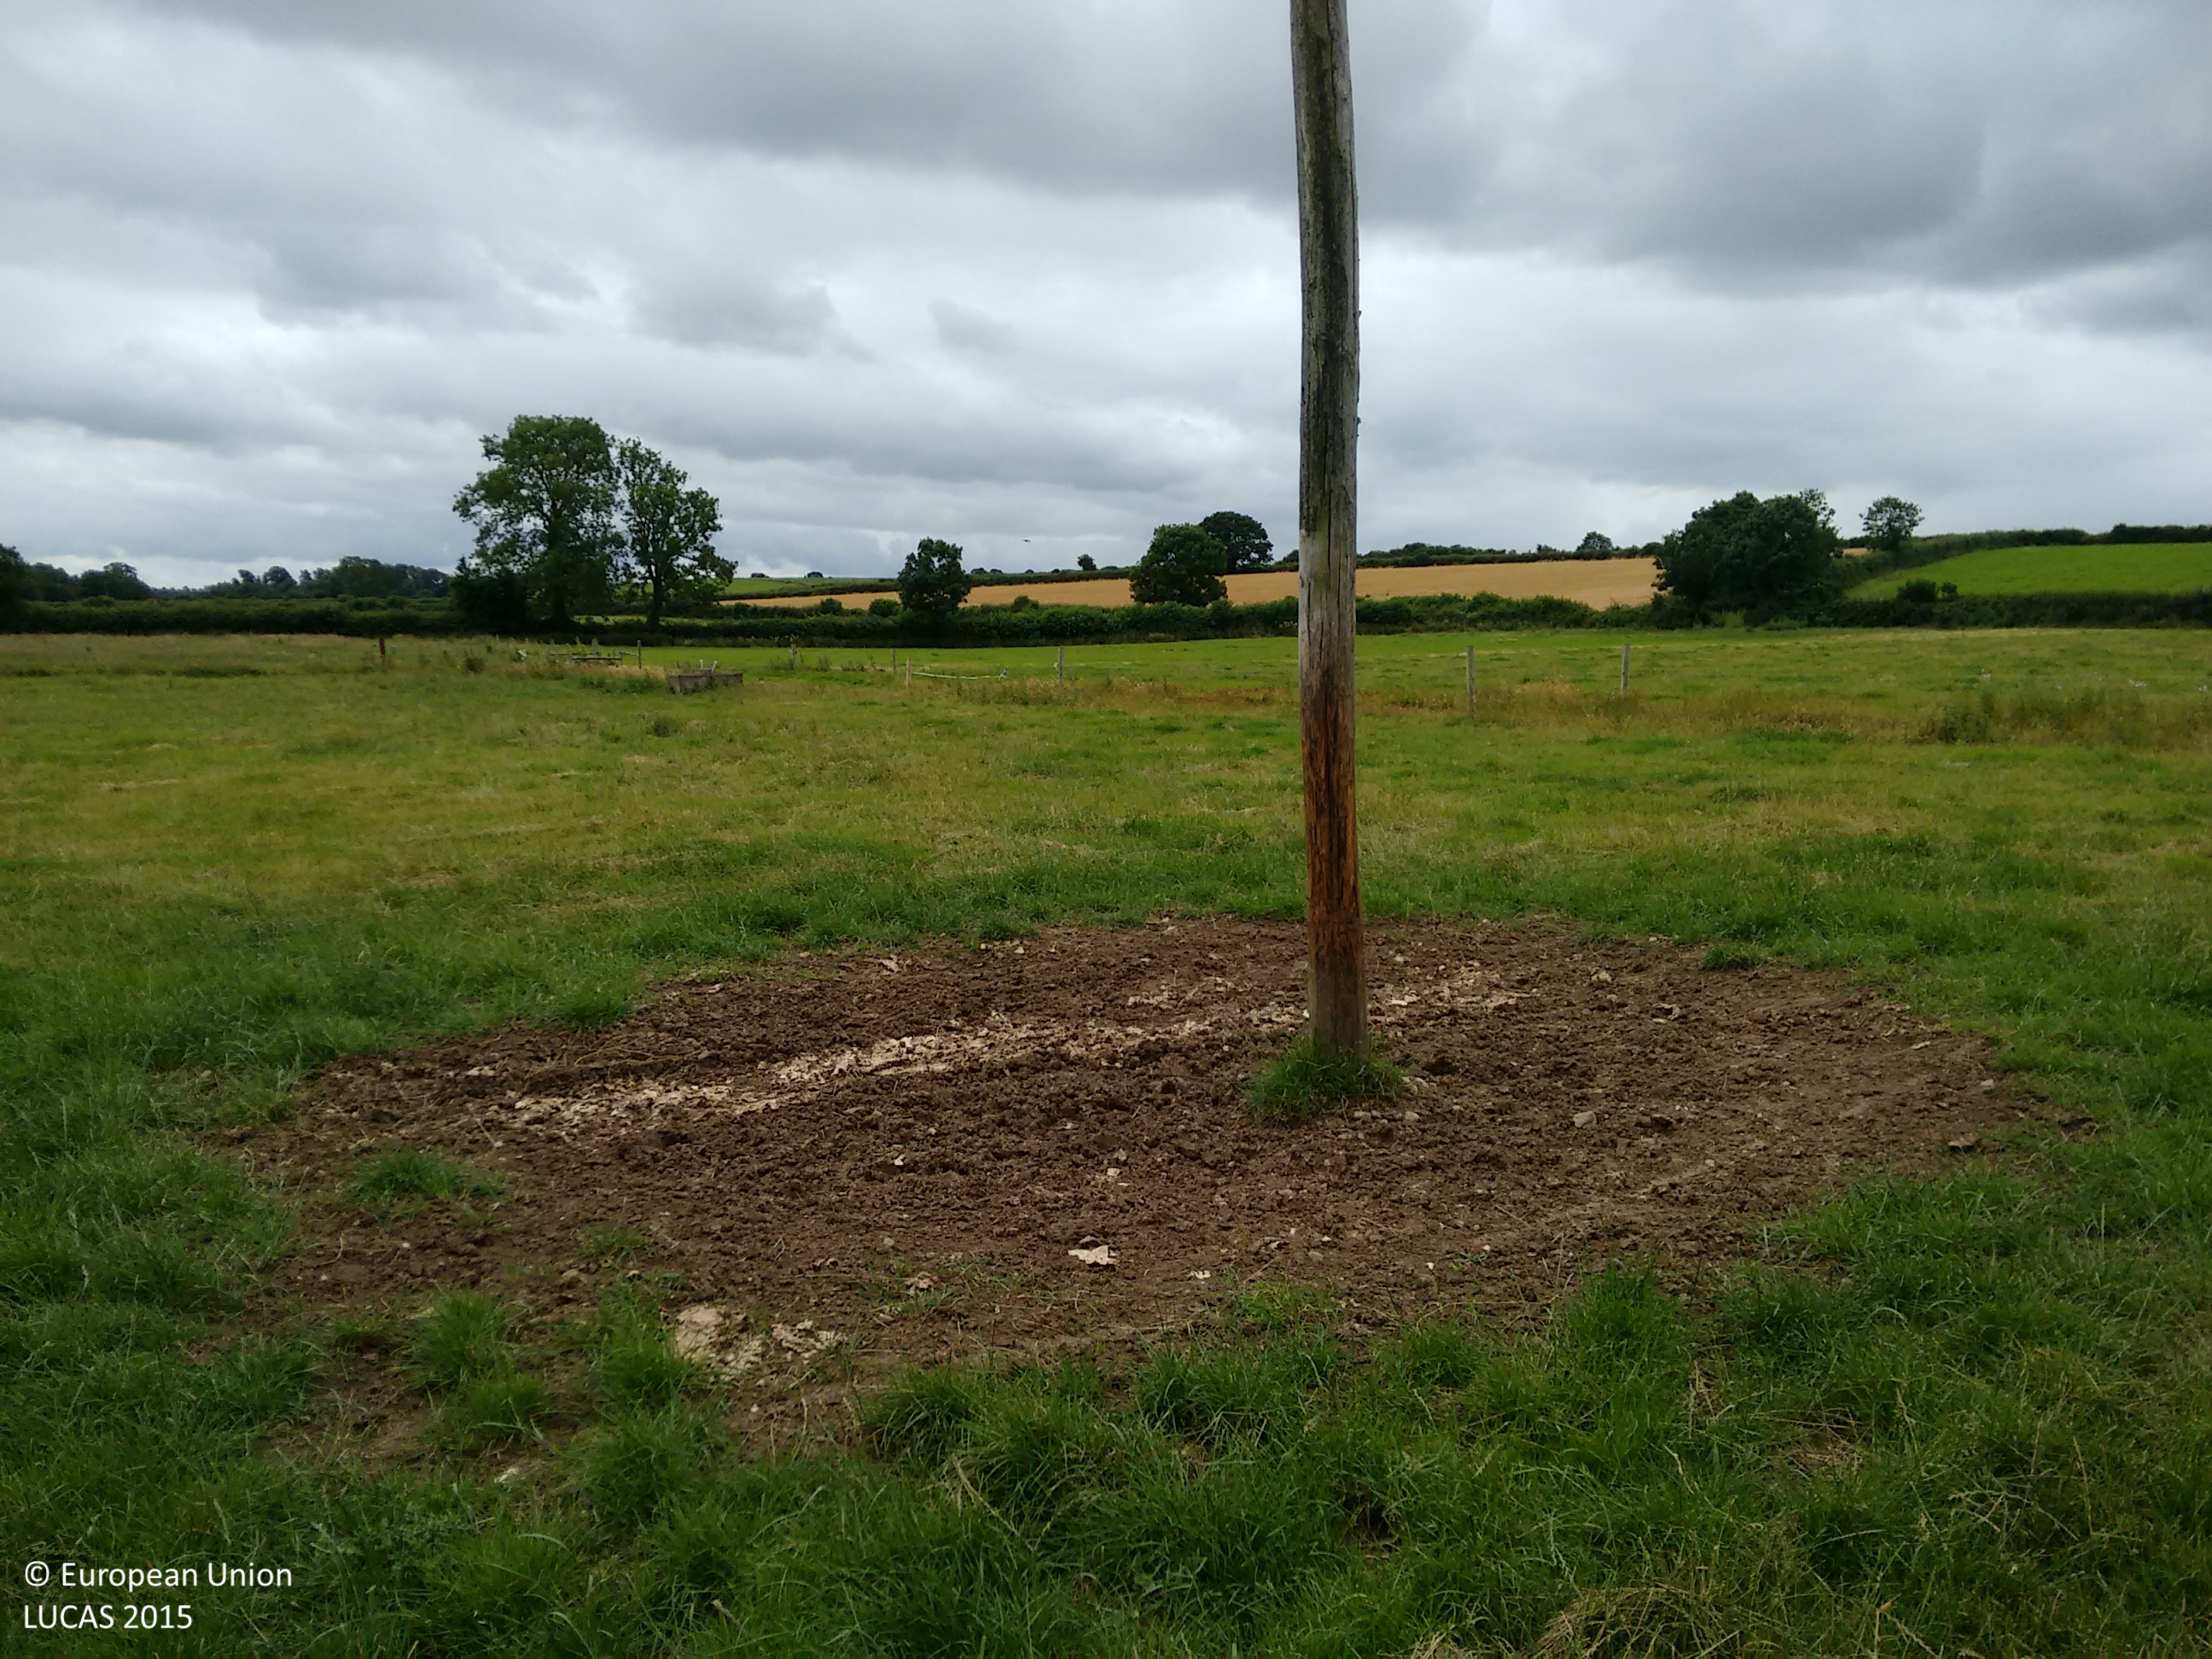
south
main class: Grassland
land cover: Grassland without tree/shrub cover
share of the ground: > 75 %
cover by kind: herbaceous plants 95 %, unconsolidated bare surface 5 %
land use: Agriculture (excluding fallow land and kitchen gardens)
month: July
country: IE
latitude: 52.6600
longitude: -7.2873
